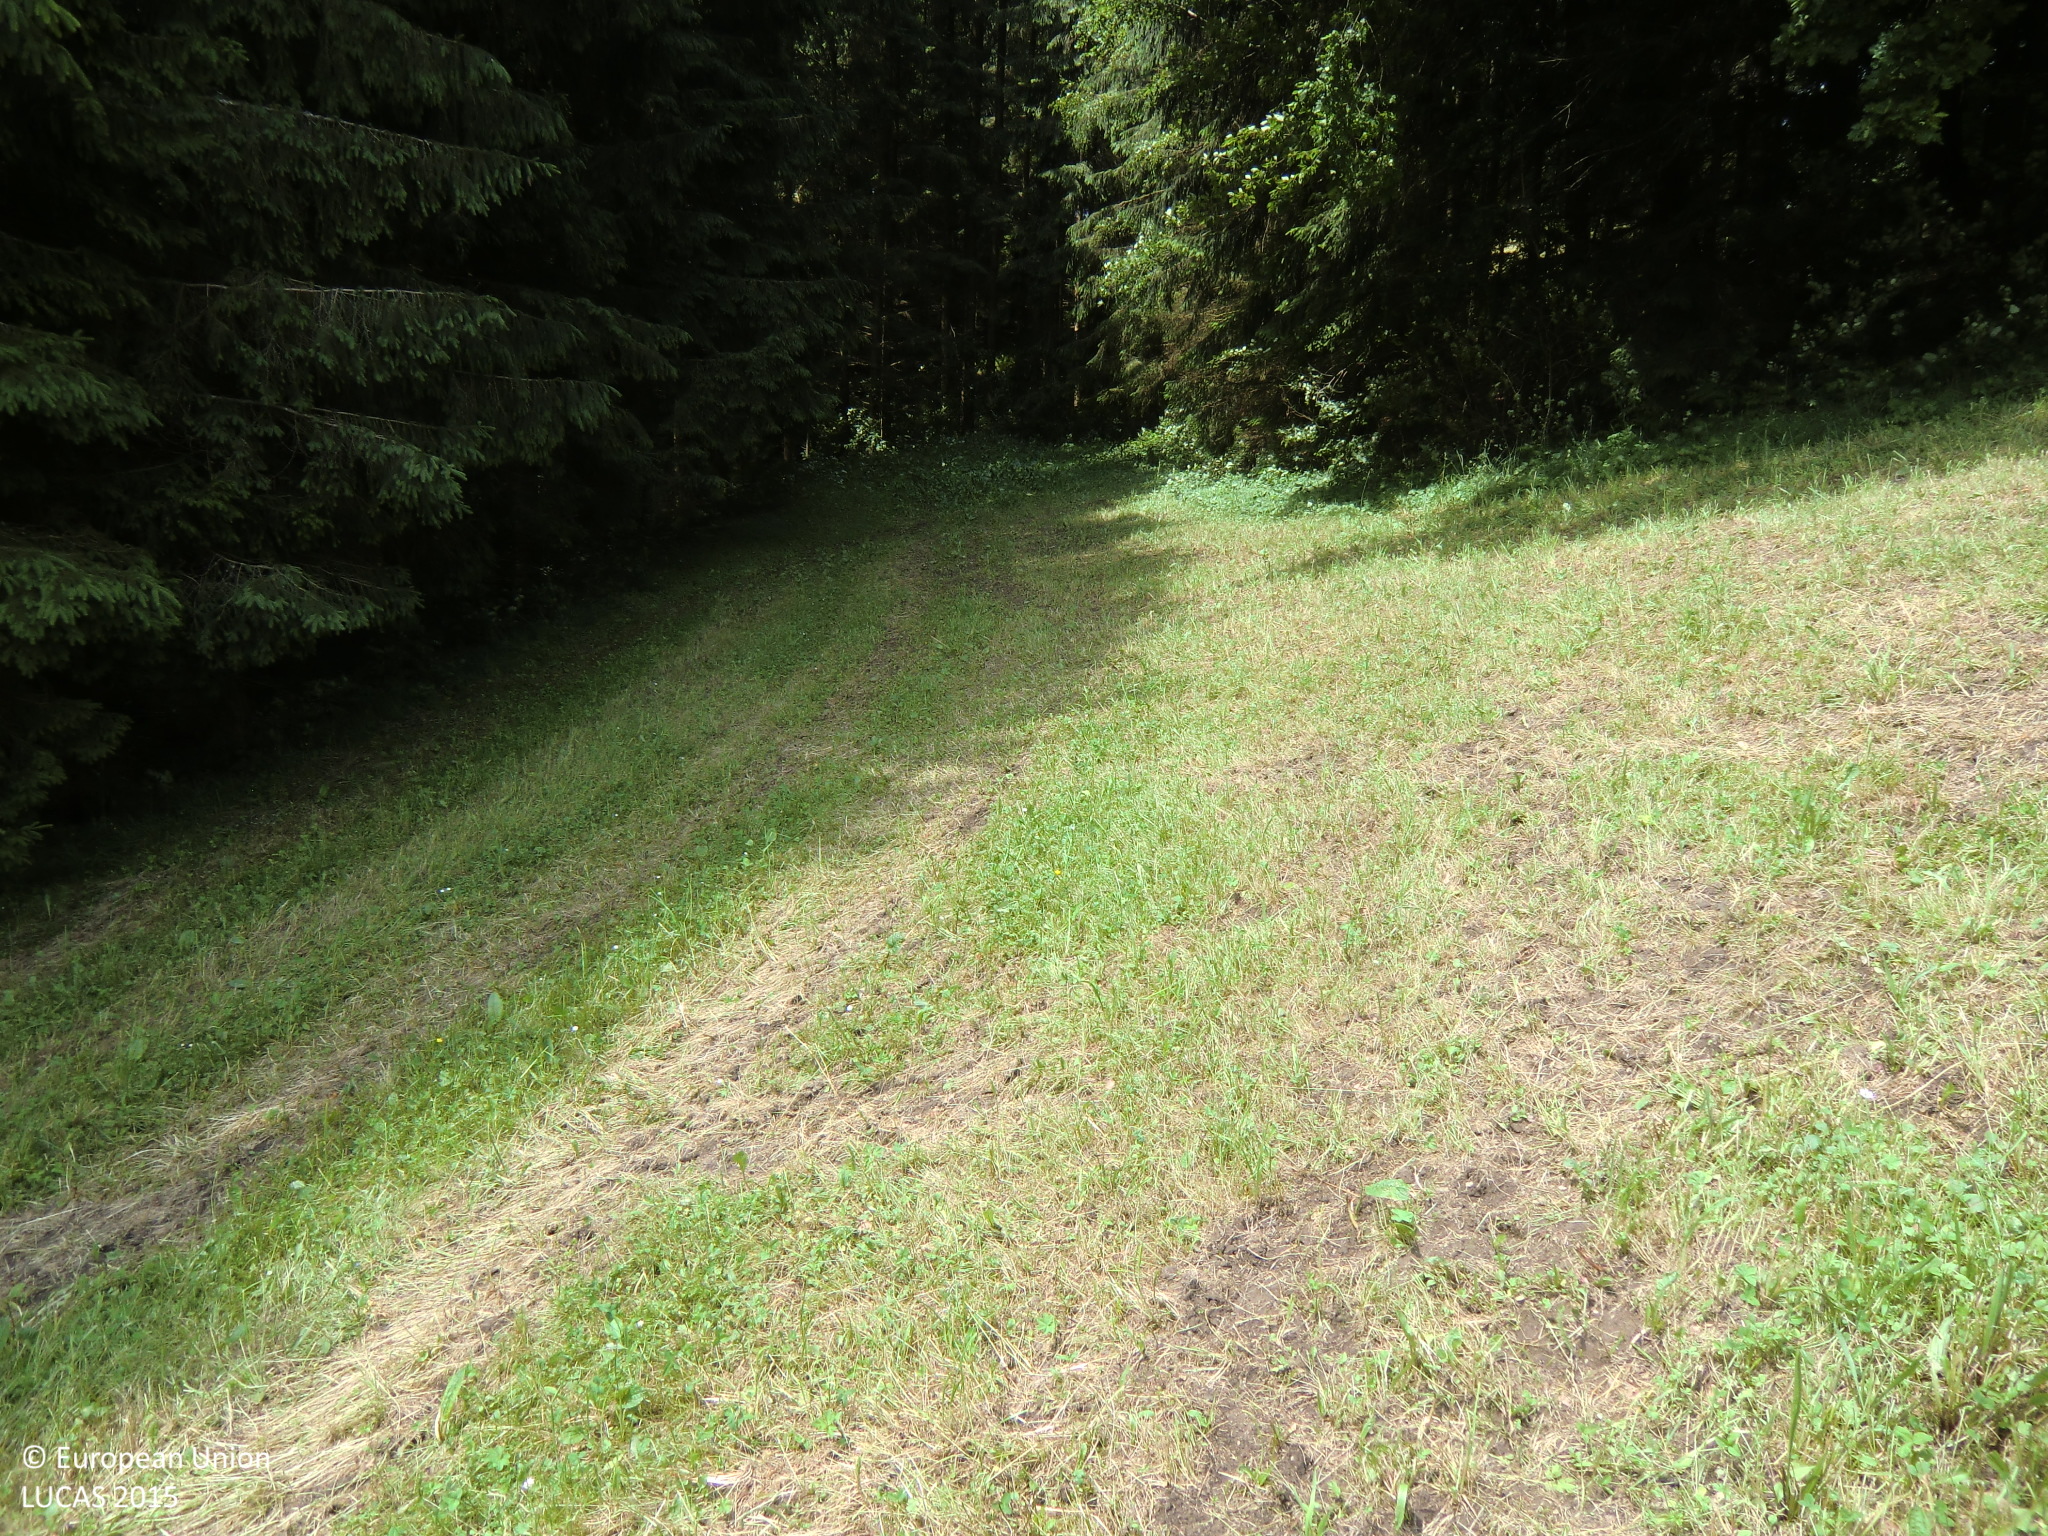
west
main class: Grassland
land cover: Grassland without tree/shrub cover
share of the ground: > 75 %
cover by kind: herbaceous plants 90 %, consolidated bare surface 10 %
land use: Agriculture (excluding fallow land and kitchen gardens)
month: June
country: AT
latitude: 48.4447
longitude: 14.7733
